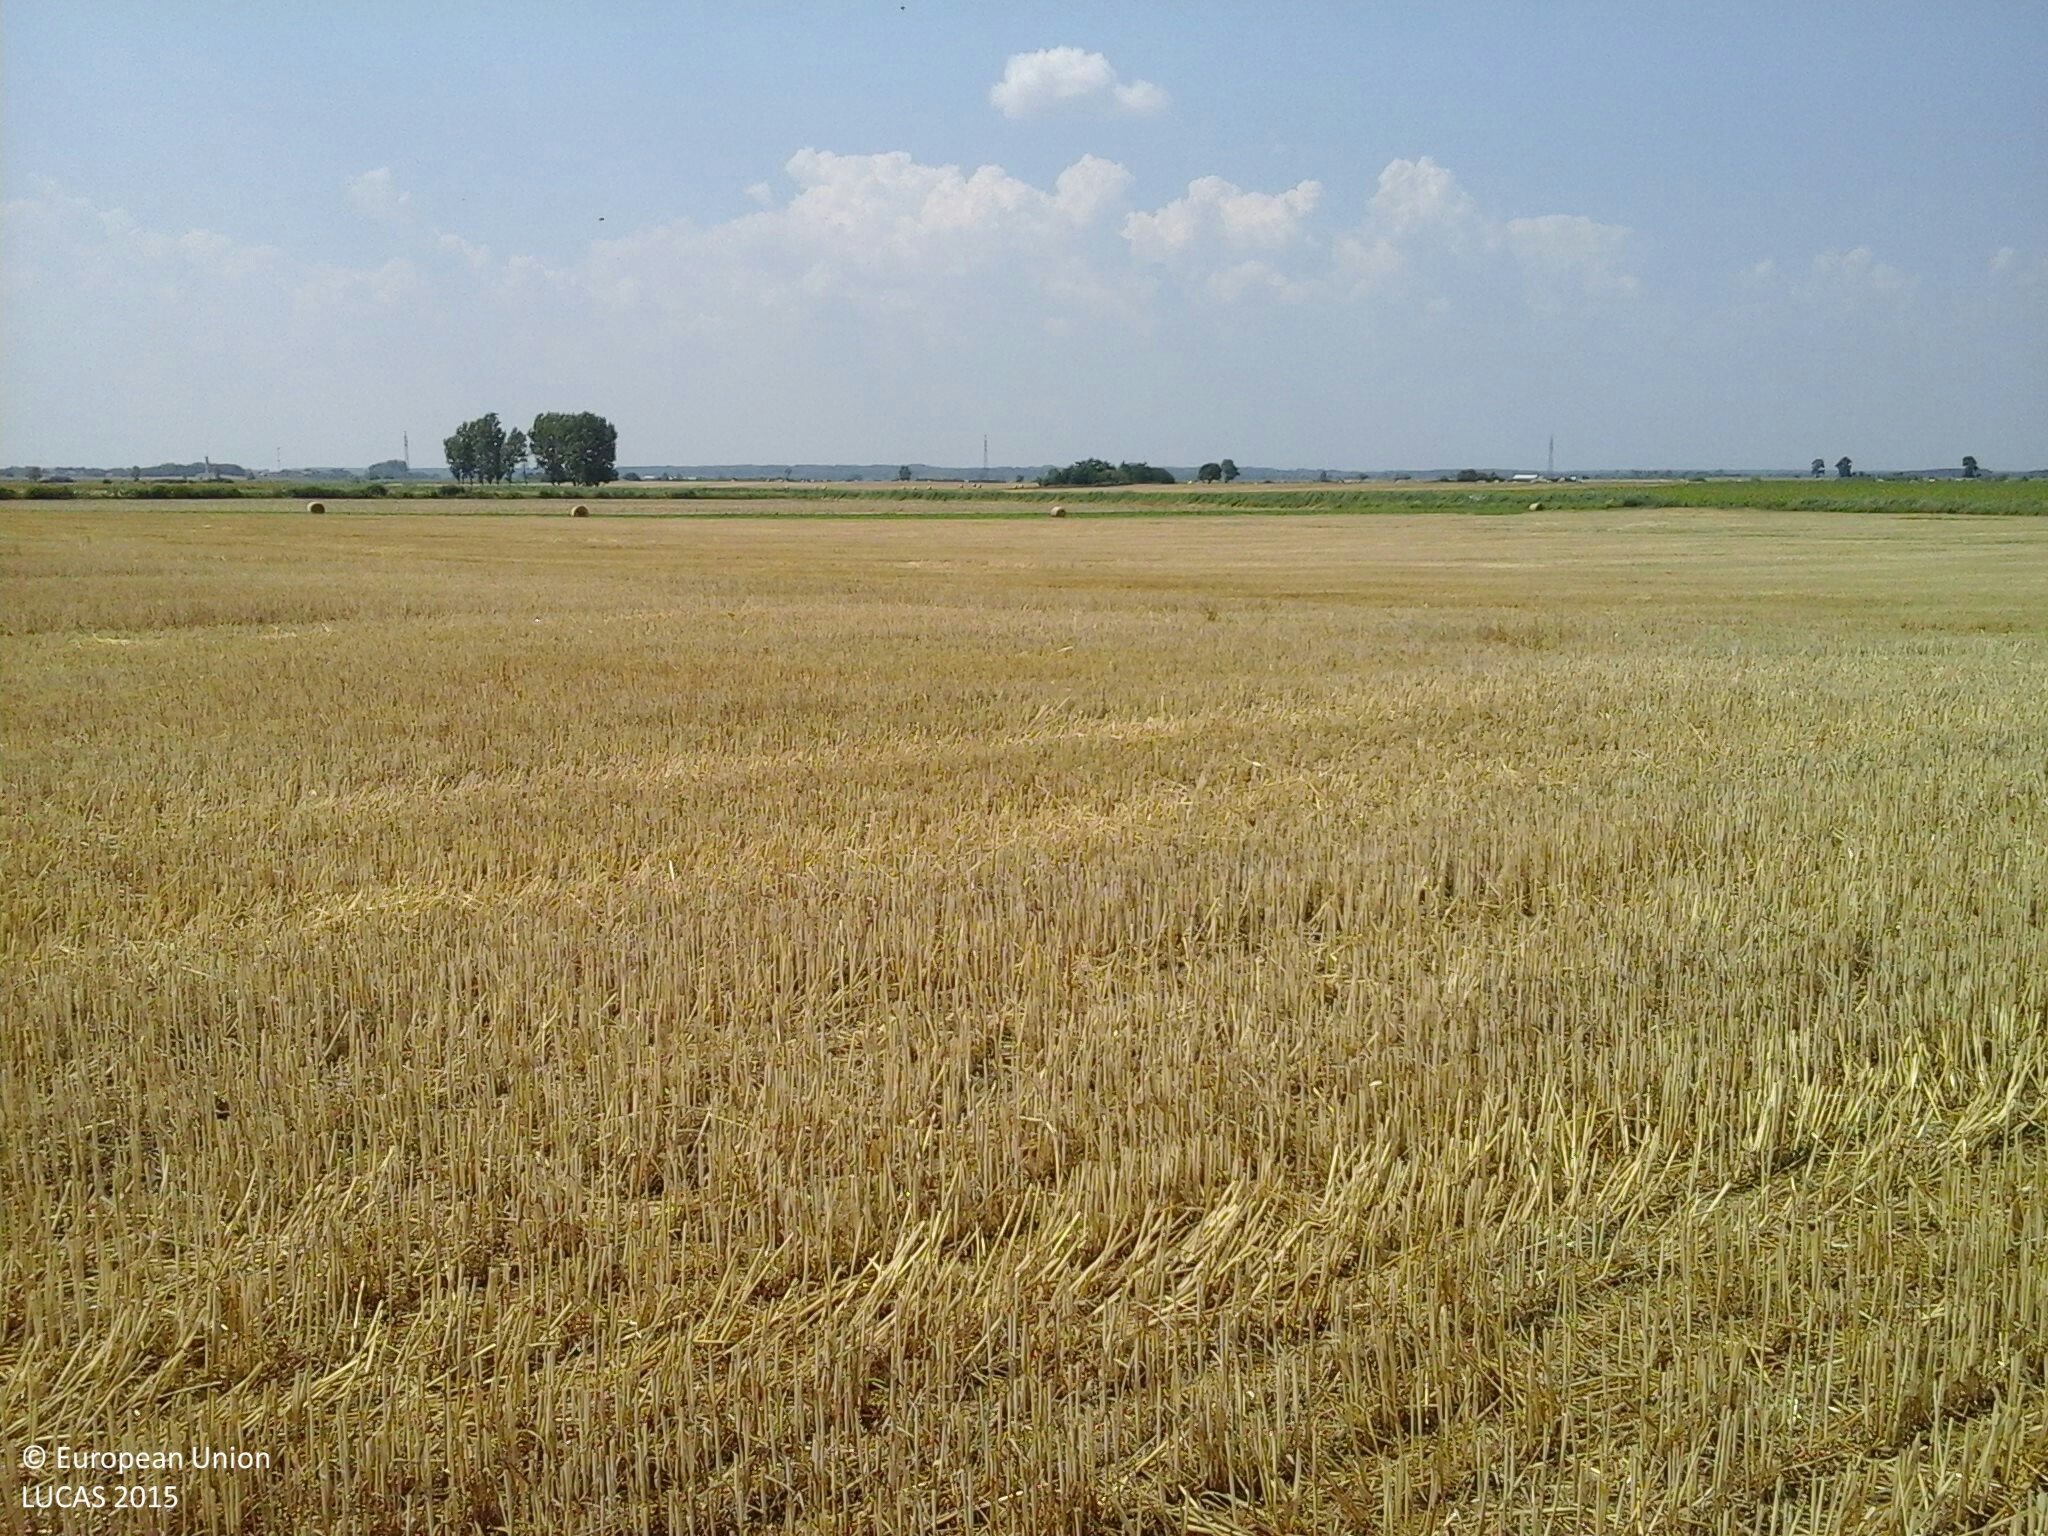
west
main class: Cropland
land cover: Common wheat
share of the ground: 25 - 50 %
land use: Agriculture (excluding fallow land and kitchen gardens)
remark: Harvested field
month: July
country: HU
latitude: 47.7016
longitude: 21.0590
